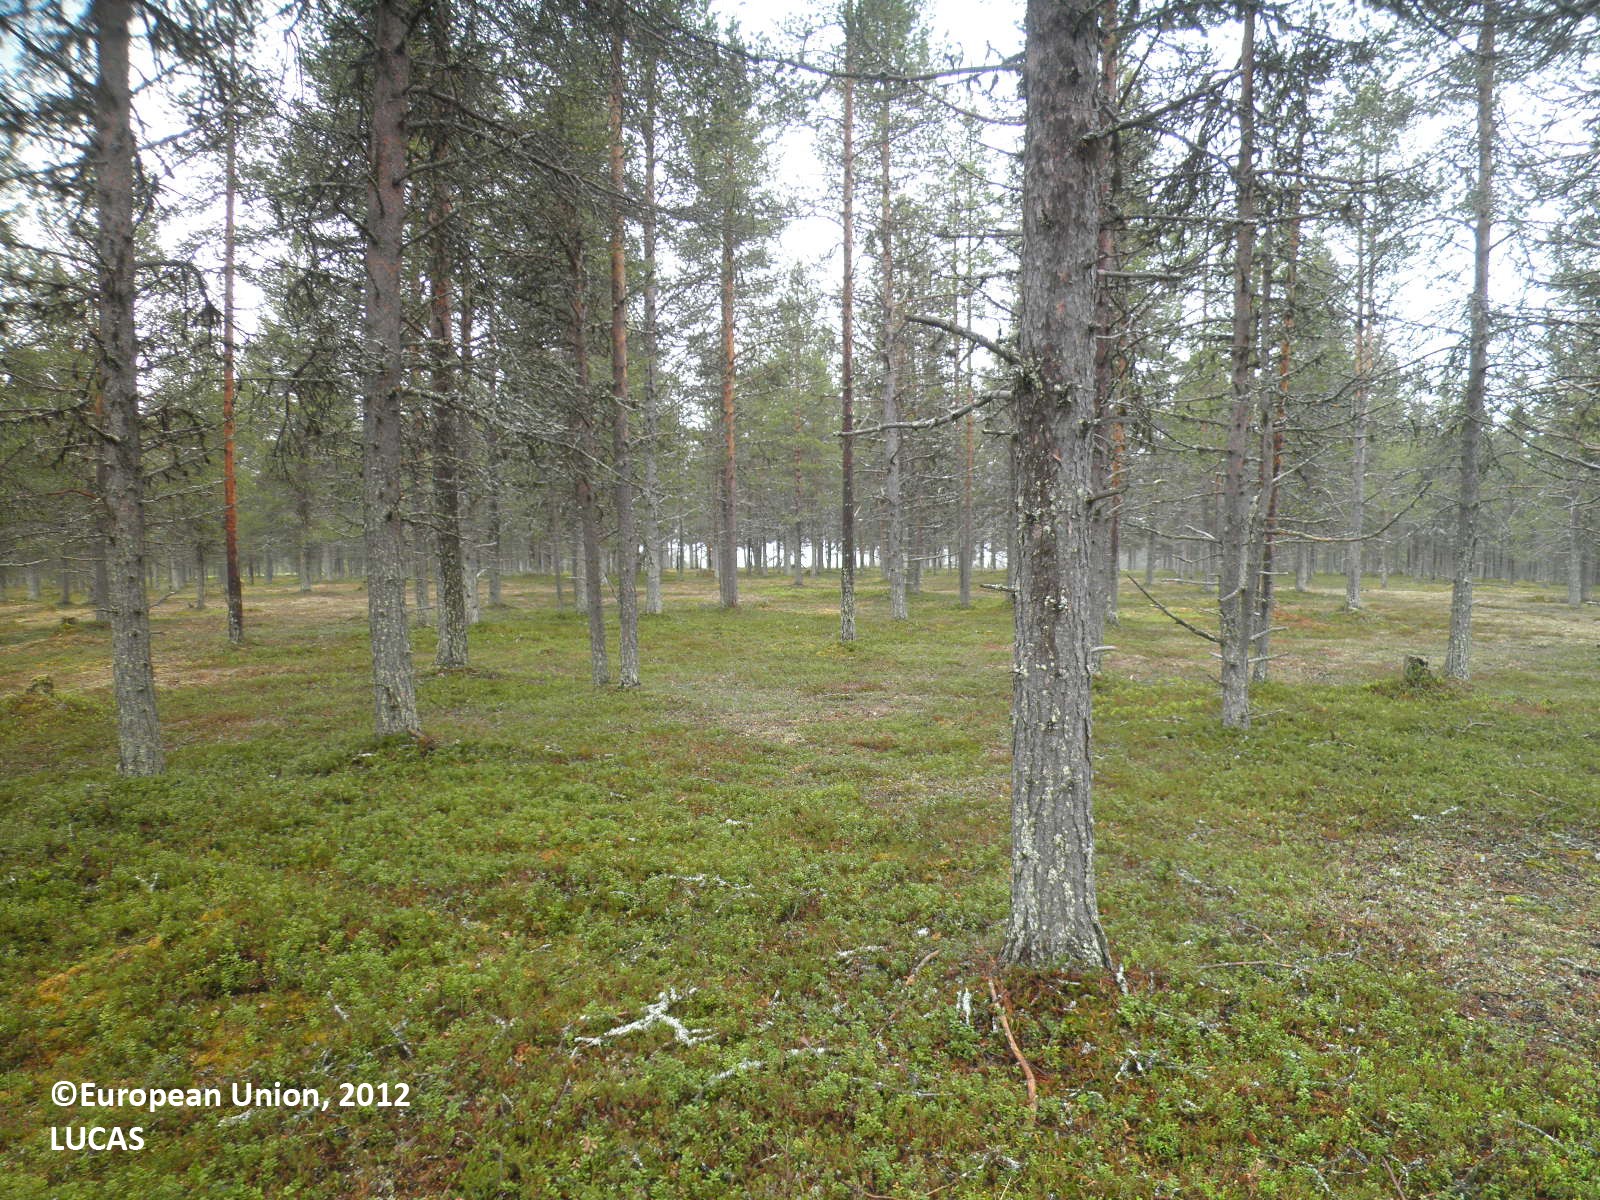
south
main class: Woodland
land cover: Pine dominated coniferous woodland
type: boreal forest
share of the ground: 25 - 50 %
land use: Forestry
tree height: > 5 m
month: June
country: FI
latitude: 68.1649
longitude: 25.7765
